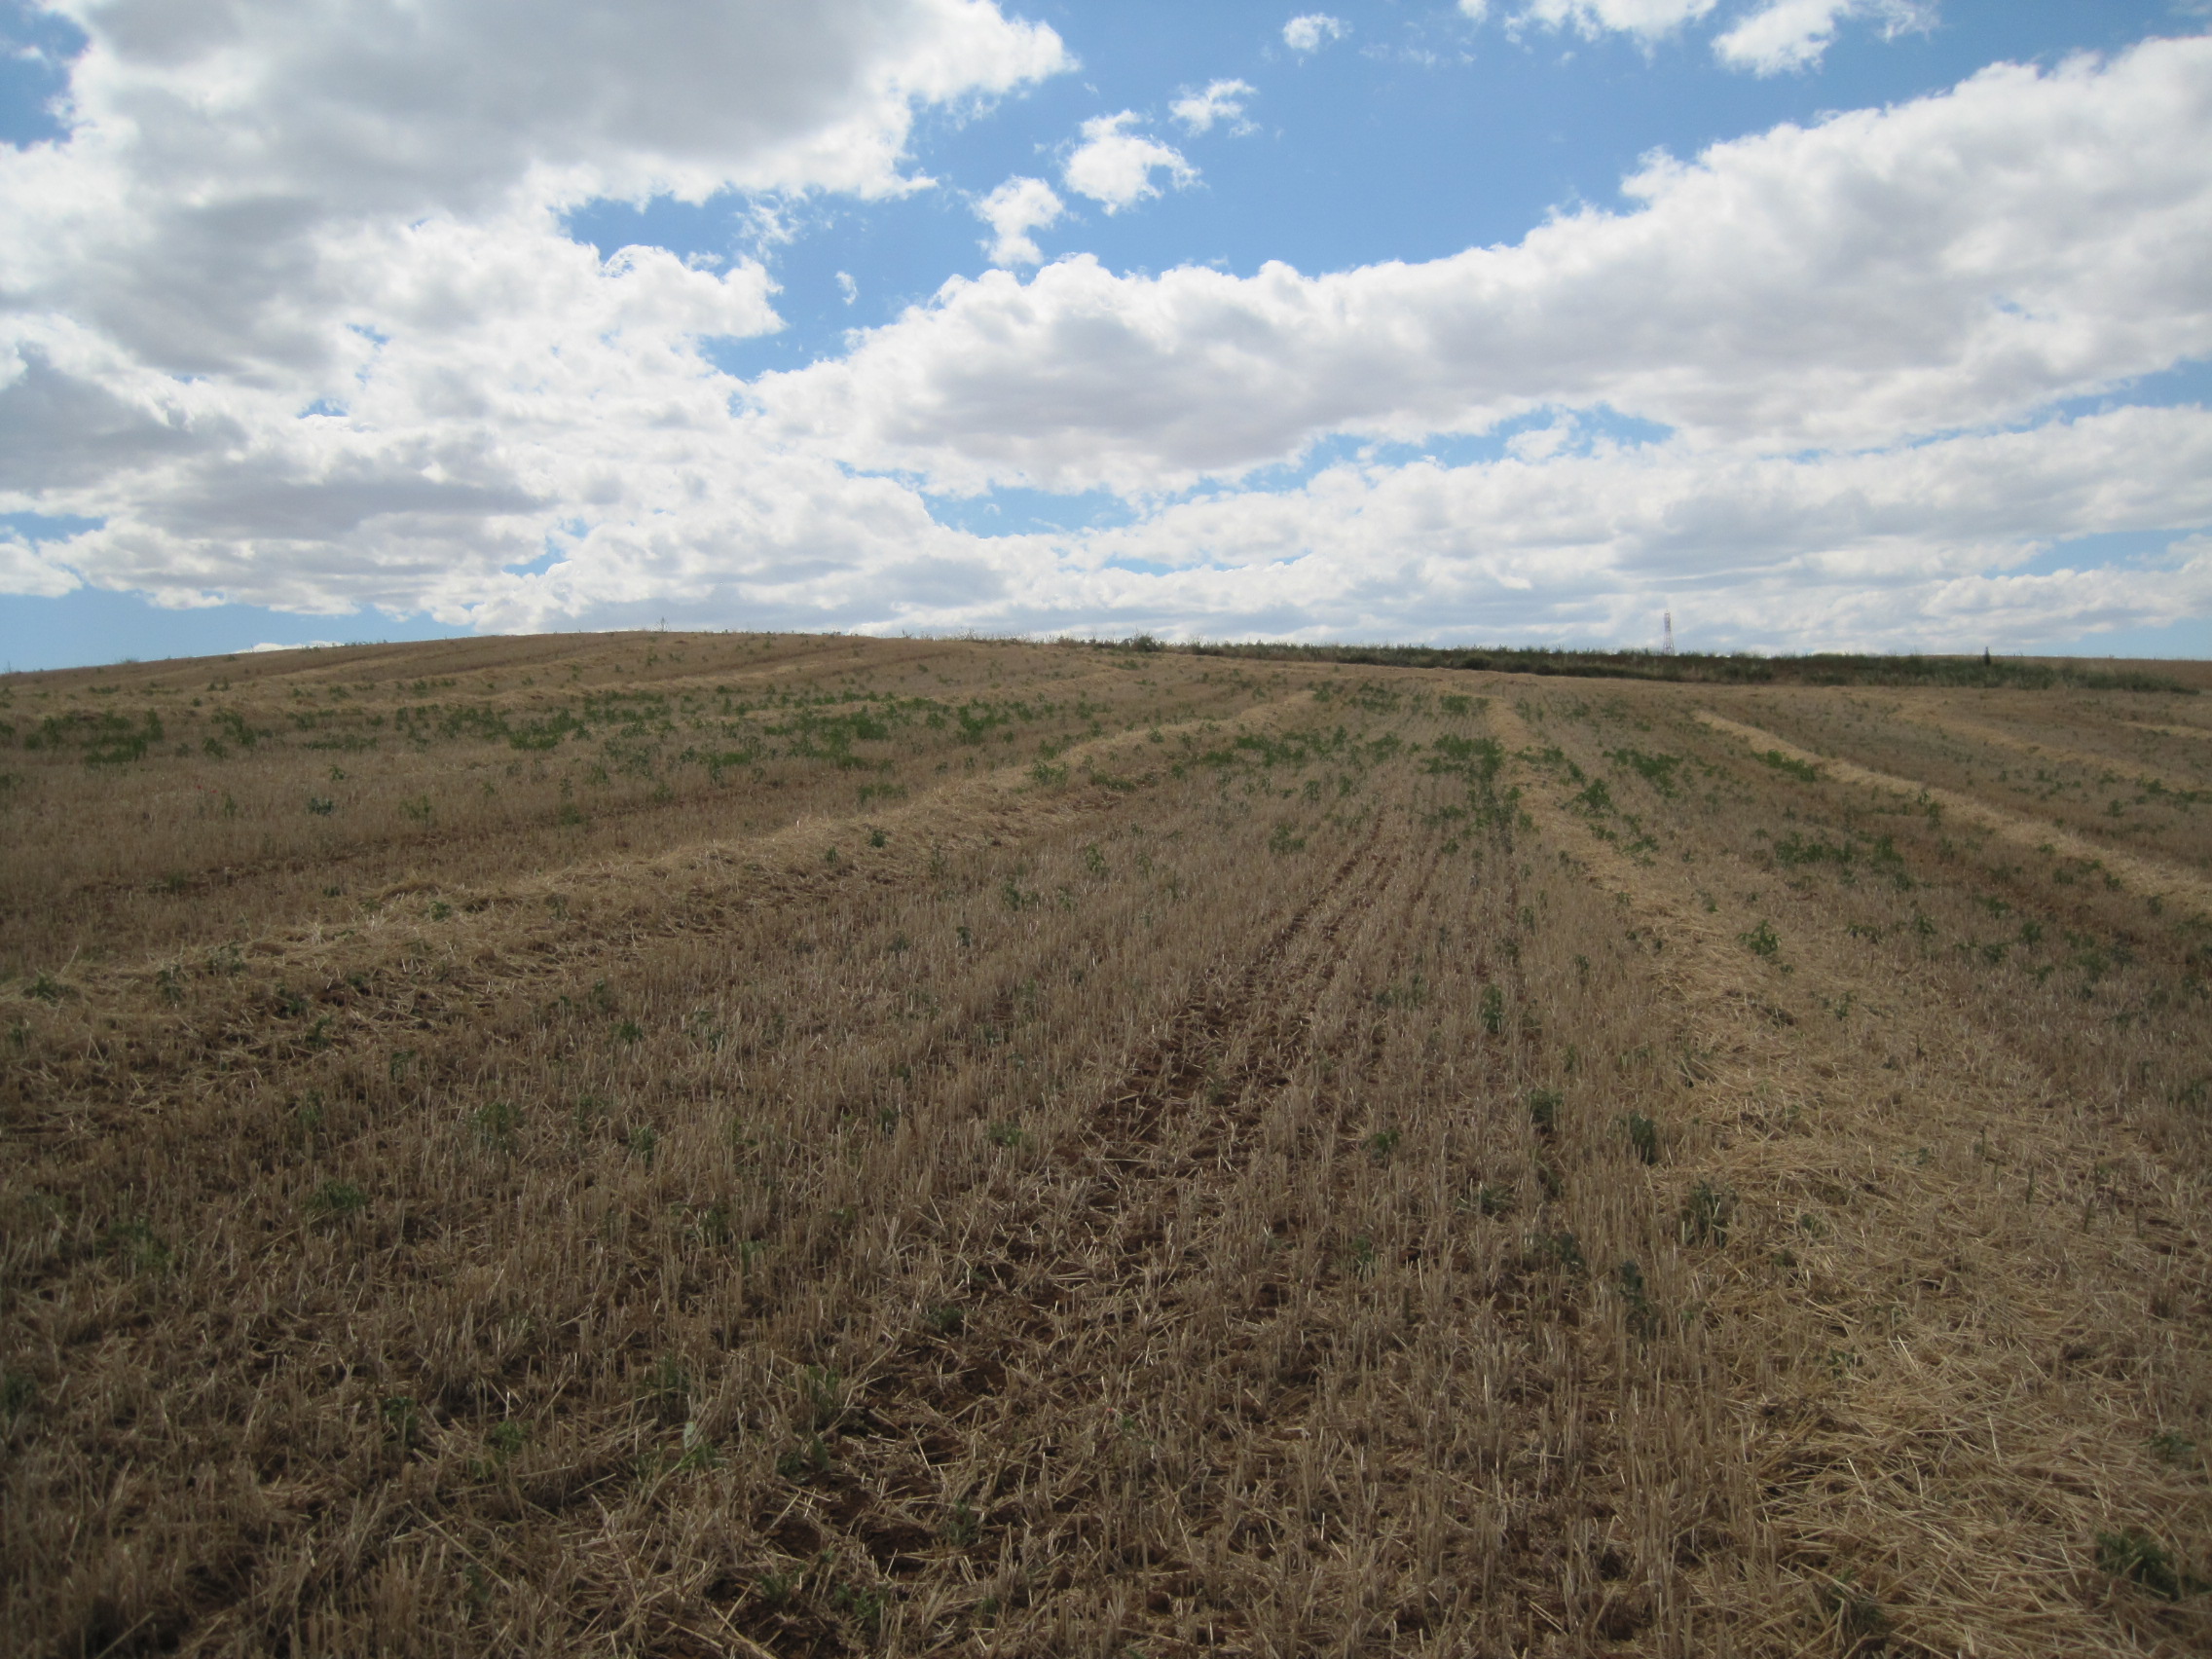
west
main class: Cropland
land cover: Common wheat
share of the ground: < 10 %
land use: Agriculture (excluding fallow land and kitchen gardens)
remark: Harvested field
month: July
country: ES
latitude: 42.1331
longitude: -5.4904
